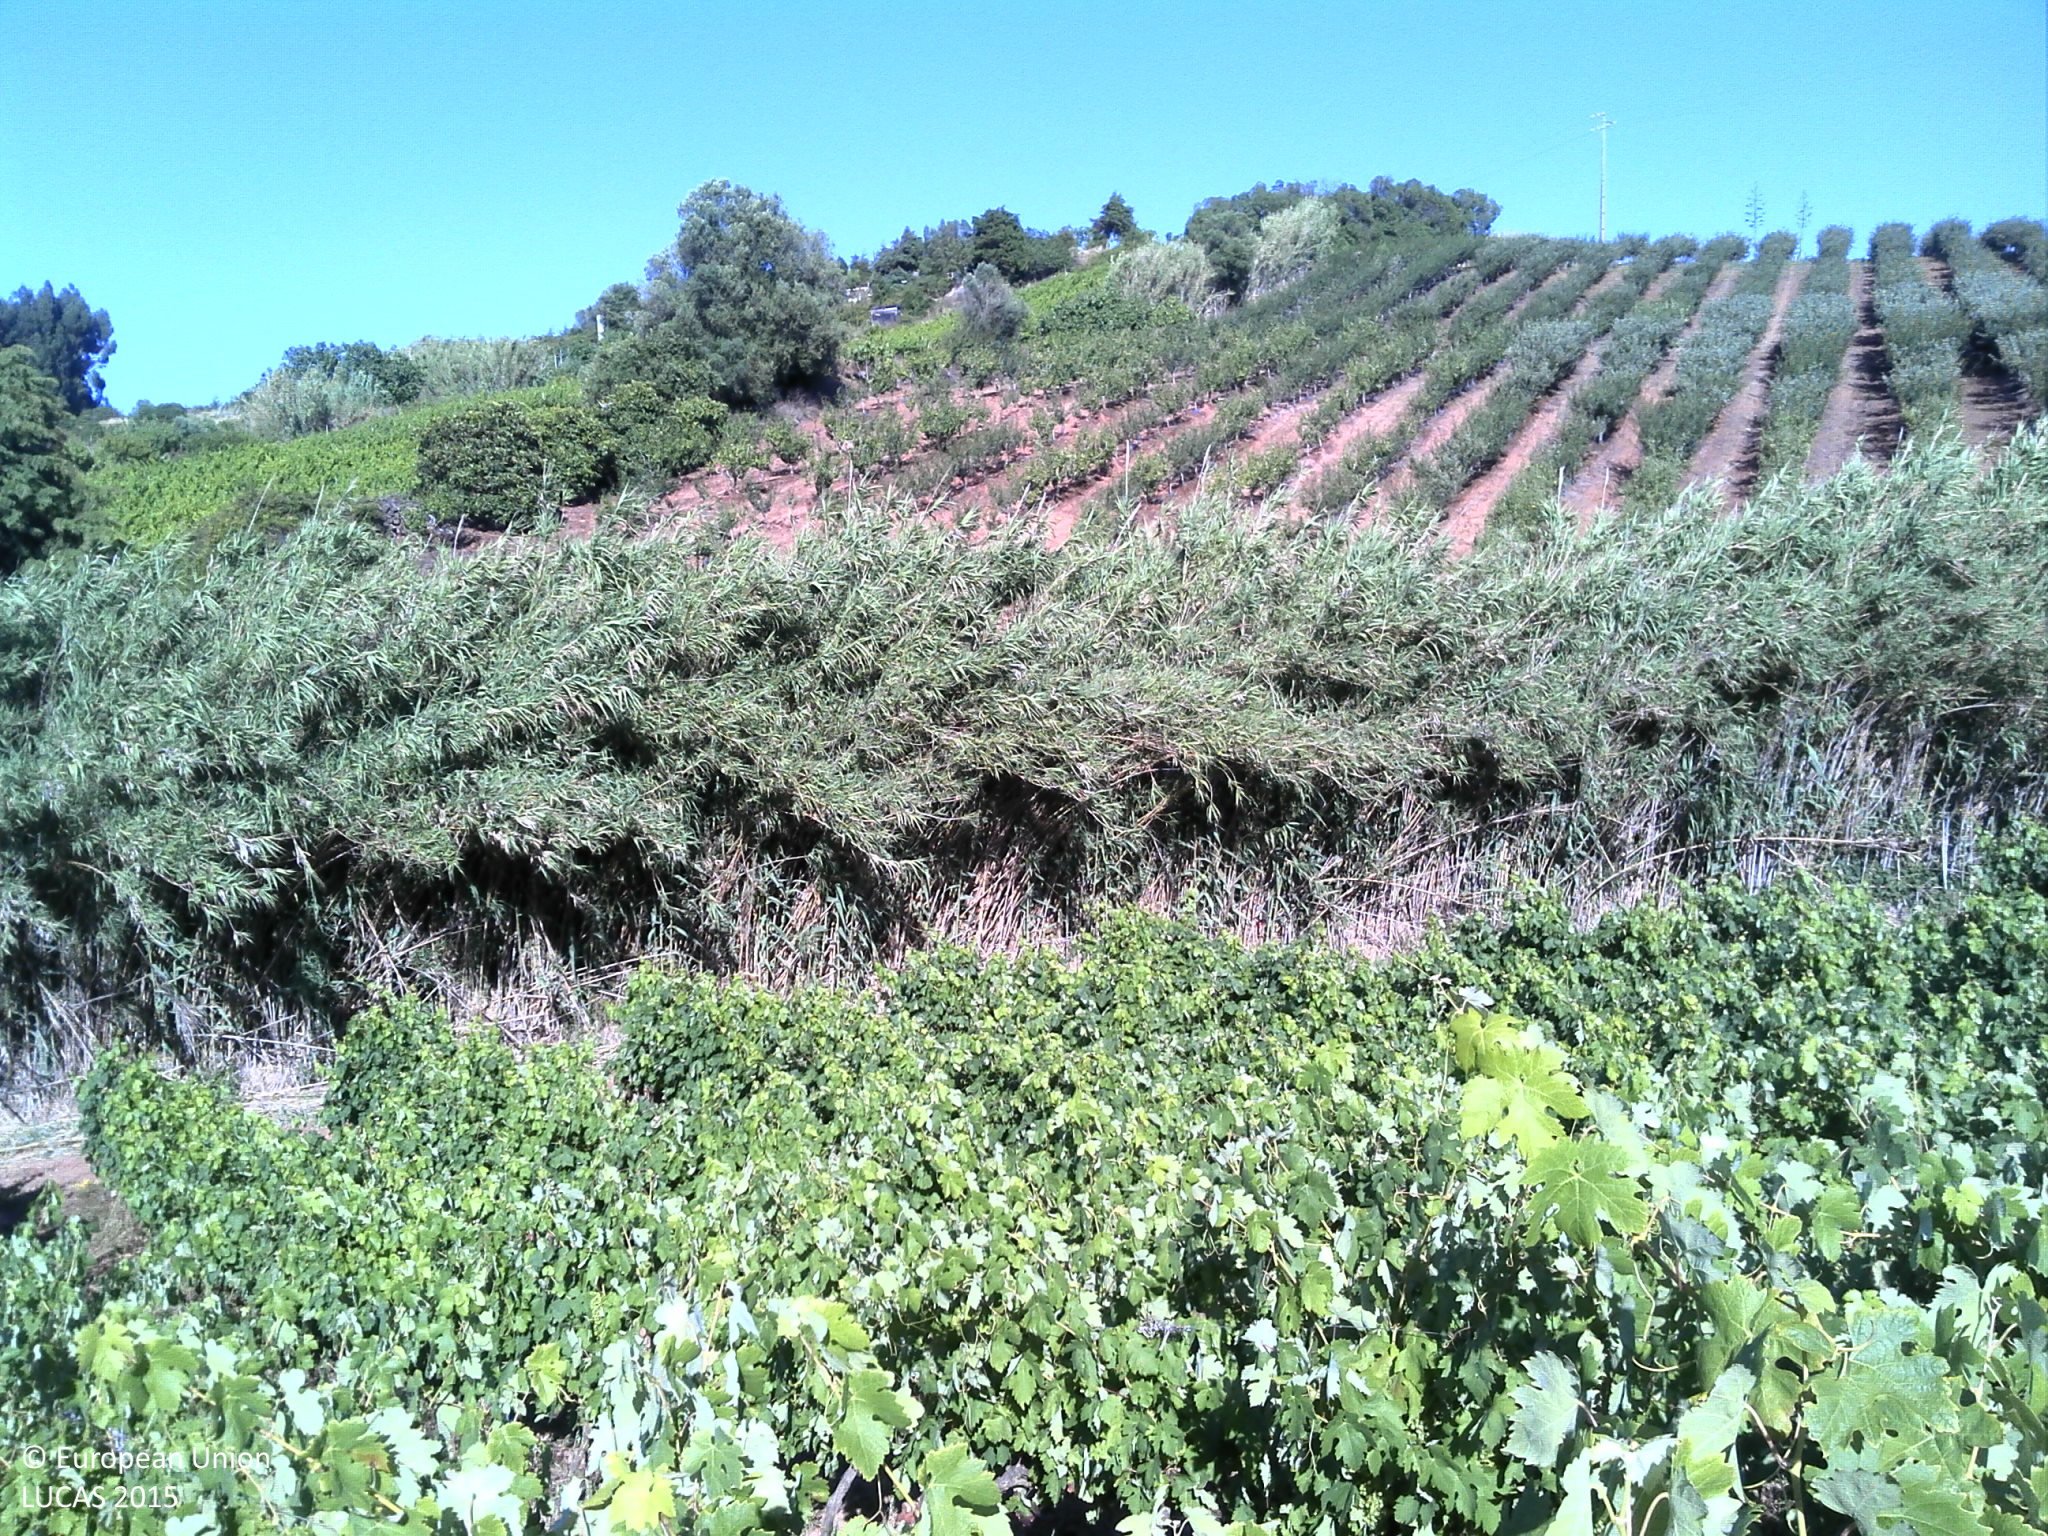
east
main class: Cropland
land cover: Vineyards
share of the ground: 50 - 75 %
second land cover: Other bare soil
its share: > 75 %
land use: Agriculture (excluding fallow land and kitchen gardens)
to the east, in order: Vineyards; Other bare soil; Vineyards; Tracks; Ditches and canals; Shrubland without tree cover; Apple fruit; Other fruit trees and berries; Vineyards; Other fresh vegetables; Artificial constructions in urban areas; Conifer hedges; Spontaneously vegetated surfaces
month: June
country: PT
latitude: 39.0444
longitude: -9.2531
